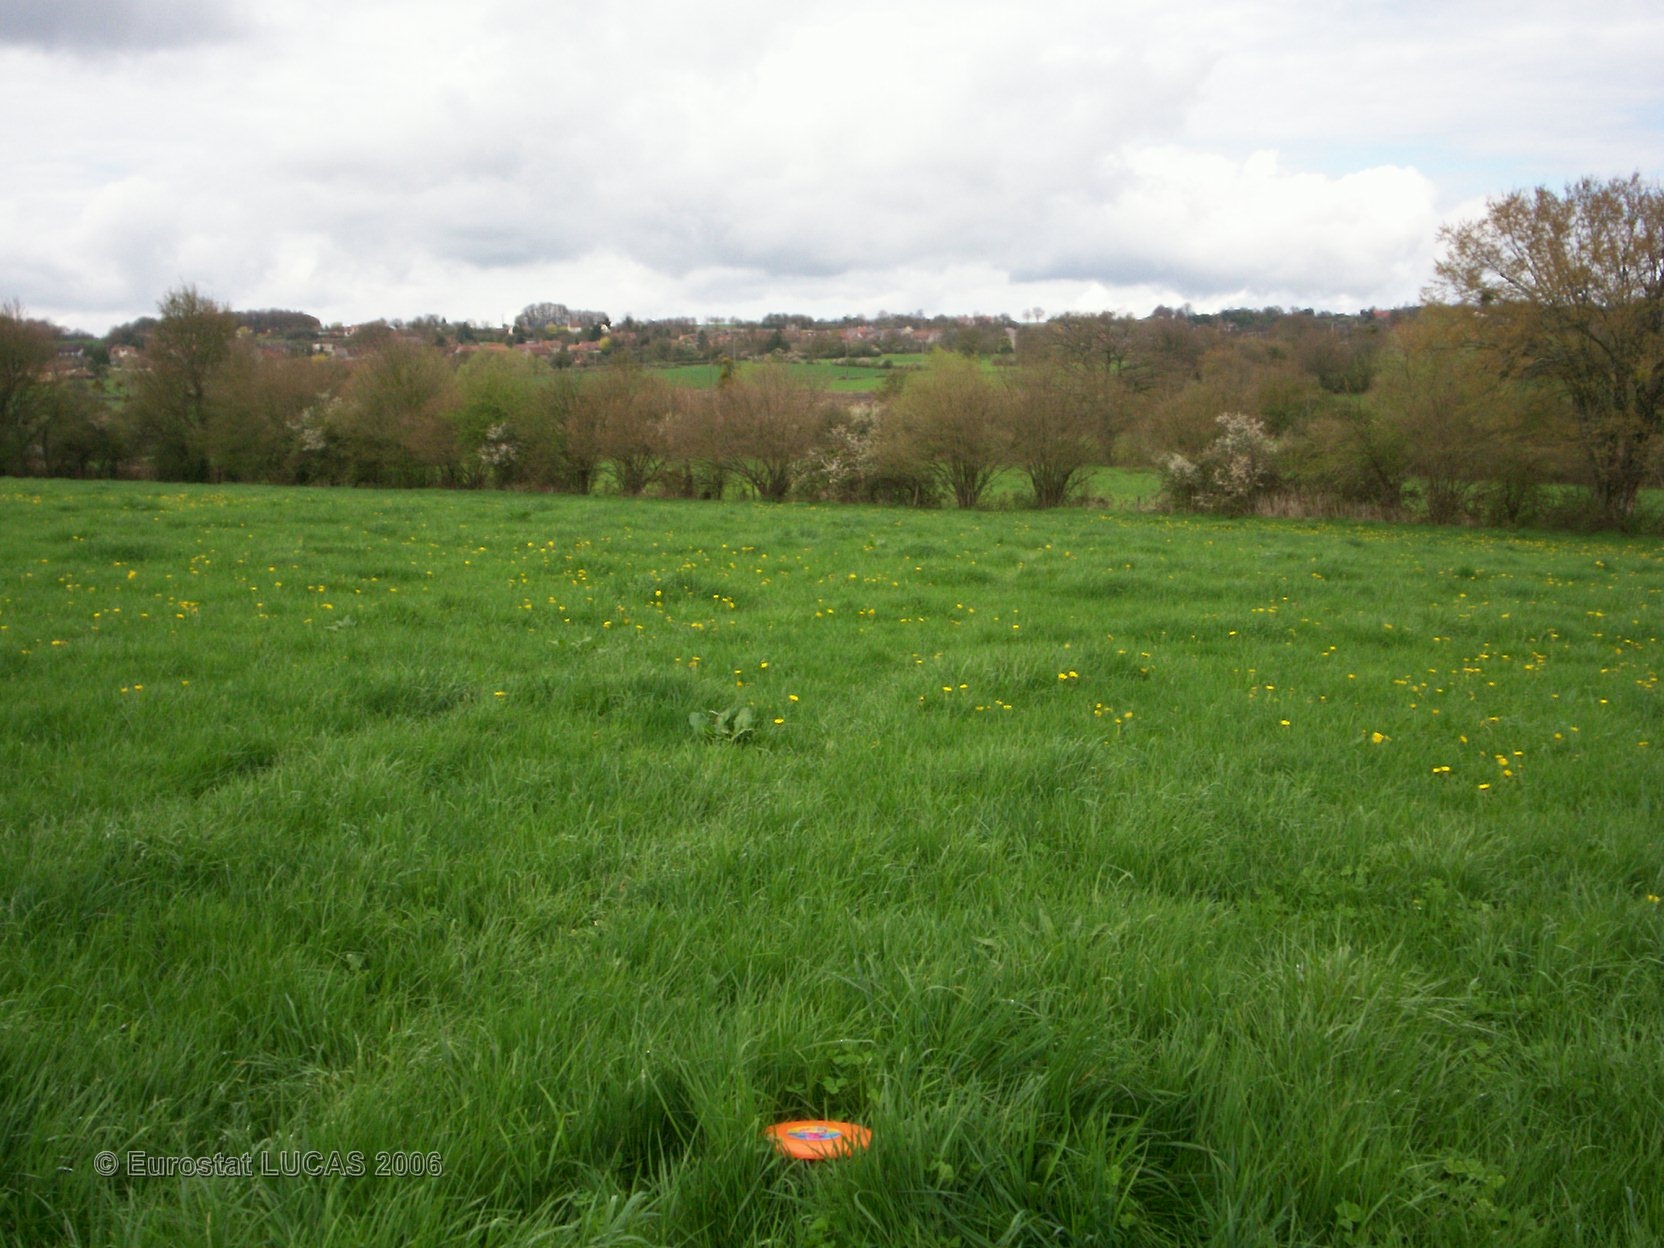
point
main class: Grassland
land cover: Grassland without tree/shrub cover
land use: Agriculture (excluding fallow land and kitchen gardens)
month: April
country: FR
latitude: 47.4447
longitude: 3.0590
